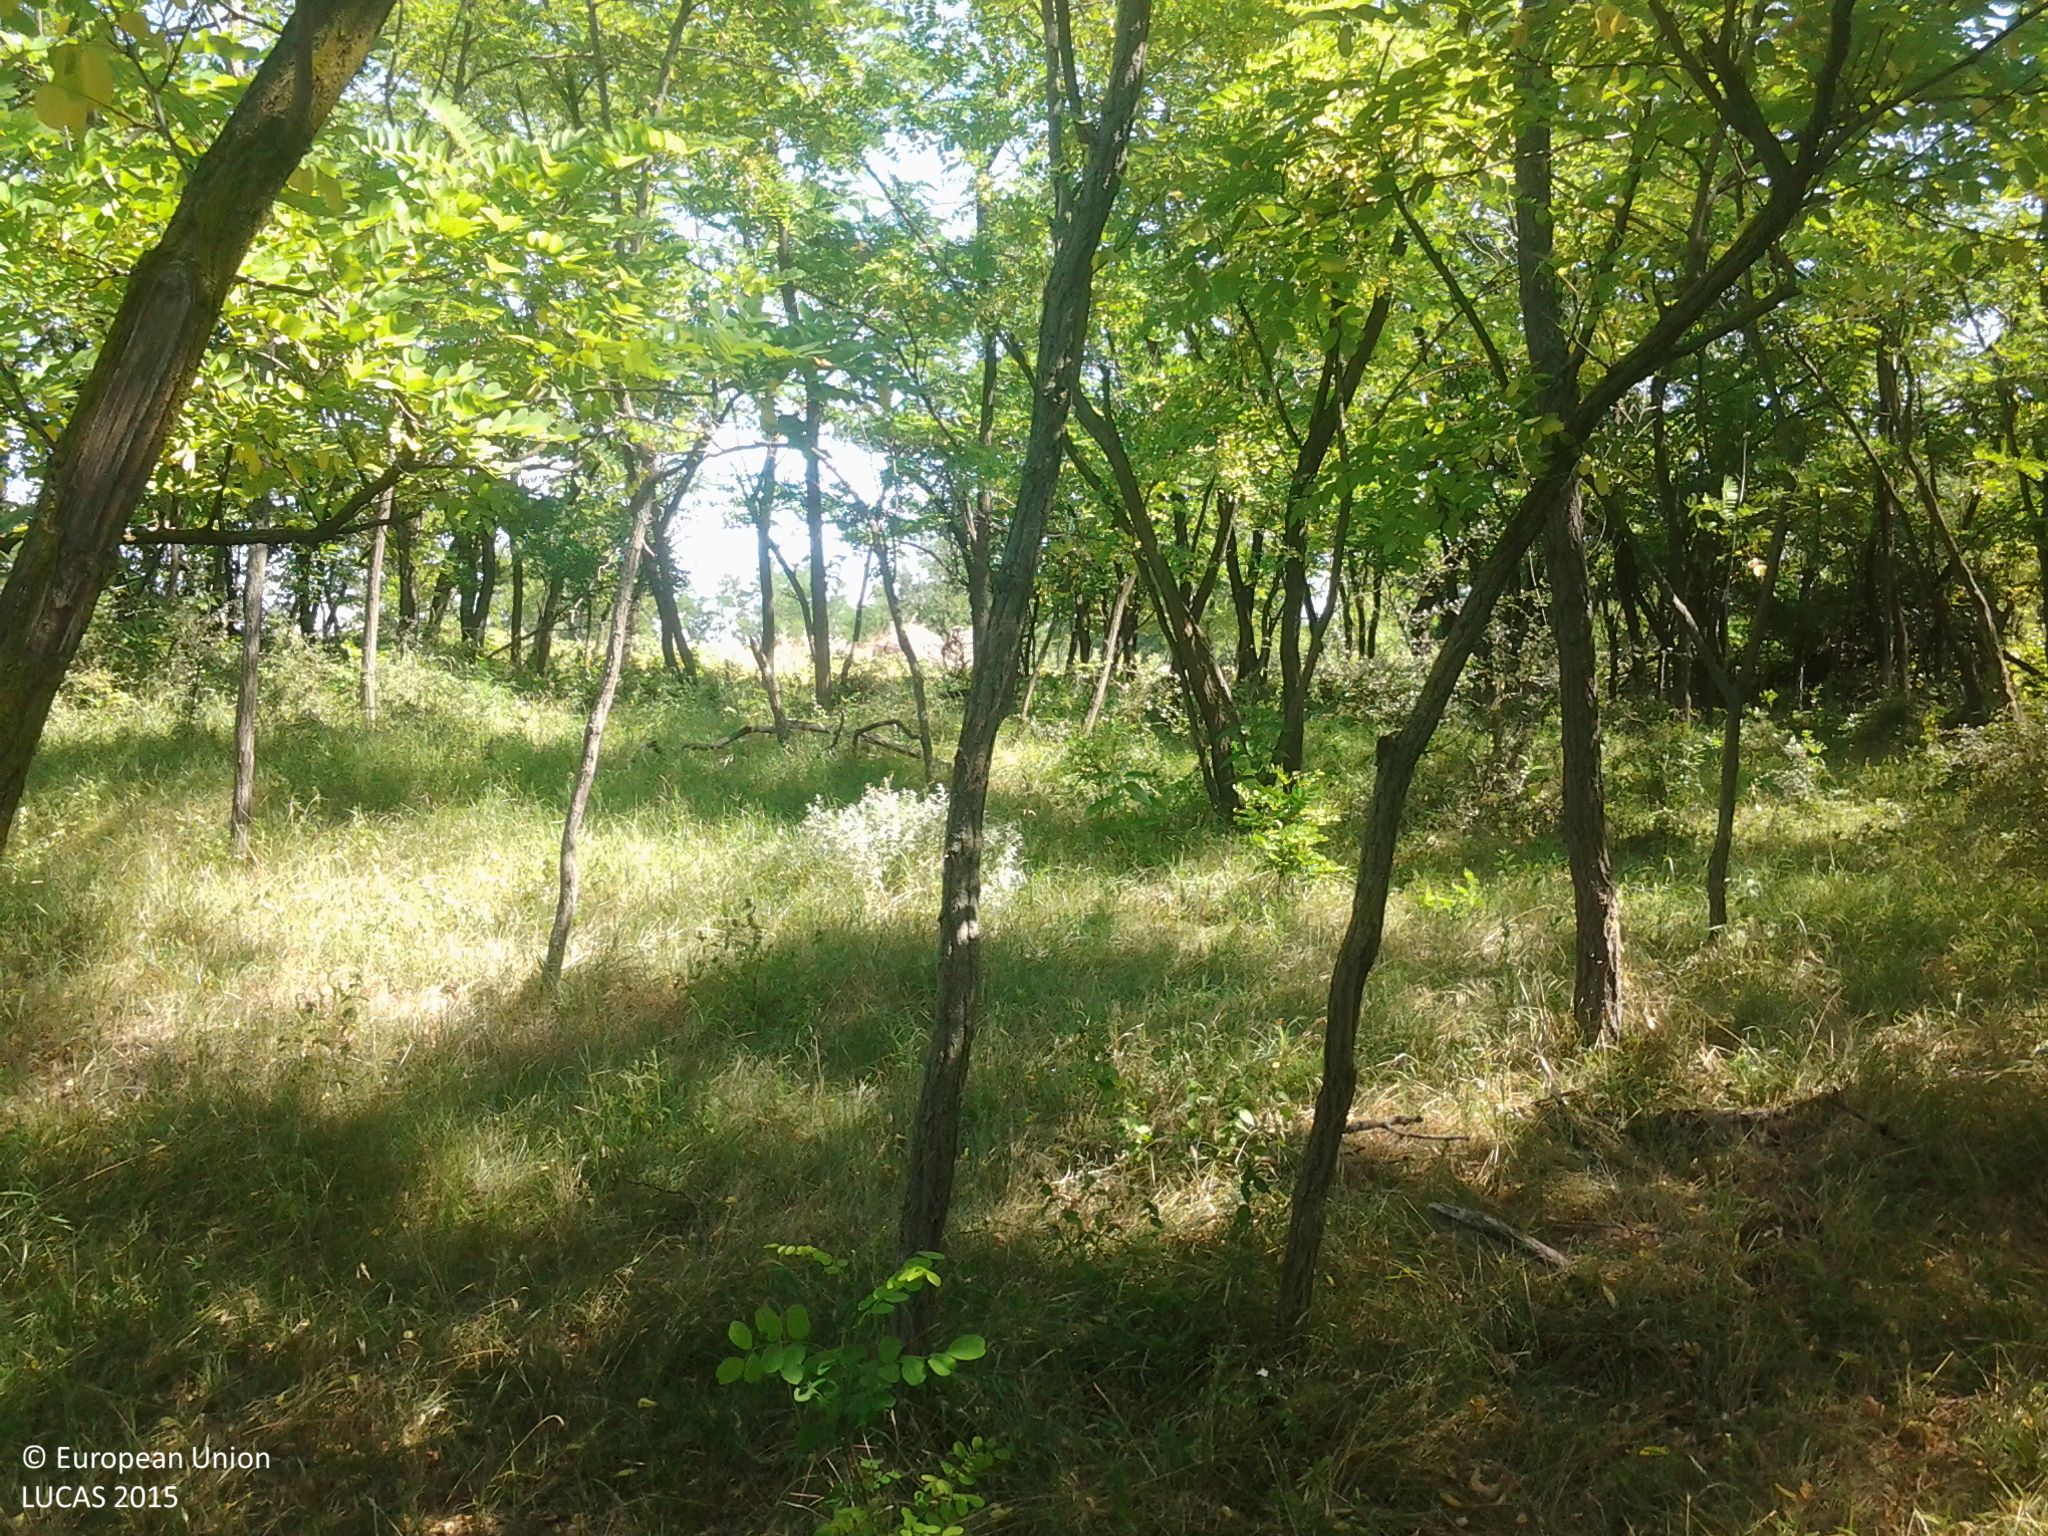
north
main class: Woodland
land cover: Broadleaved woodland
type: exotic forest
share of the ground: 50 - 75 %
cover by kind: broadleaved forest trees 70 %, herbaceous plants 30 %
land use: Forestry
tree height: > 5 m
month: July
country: HU
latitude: 46.5395
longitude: 19.5500
